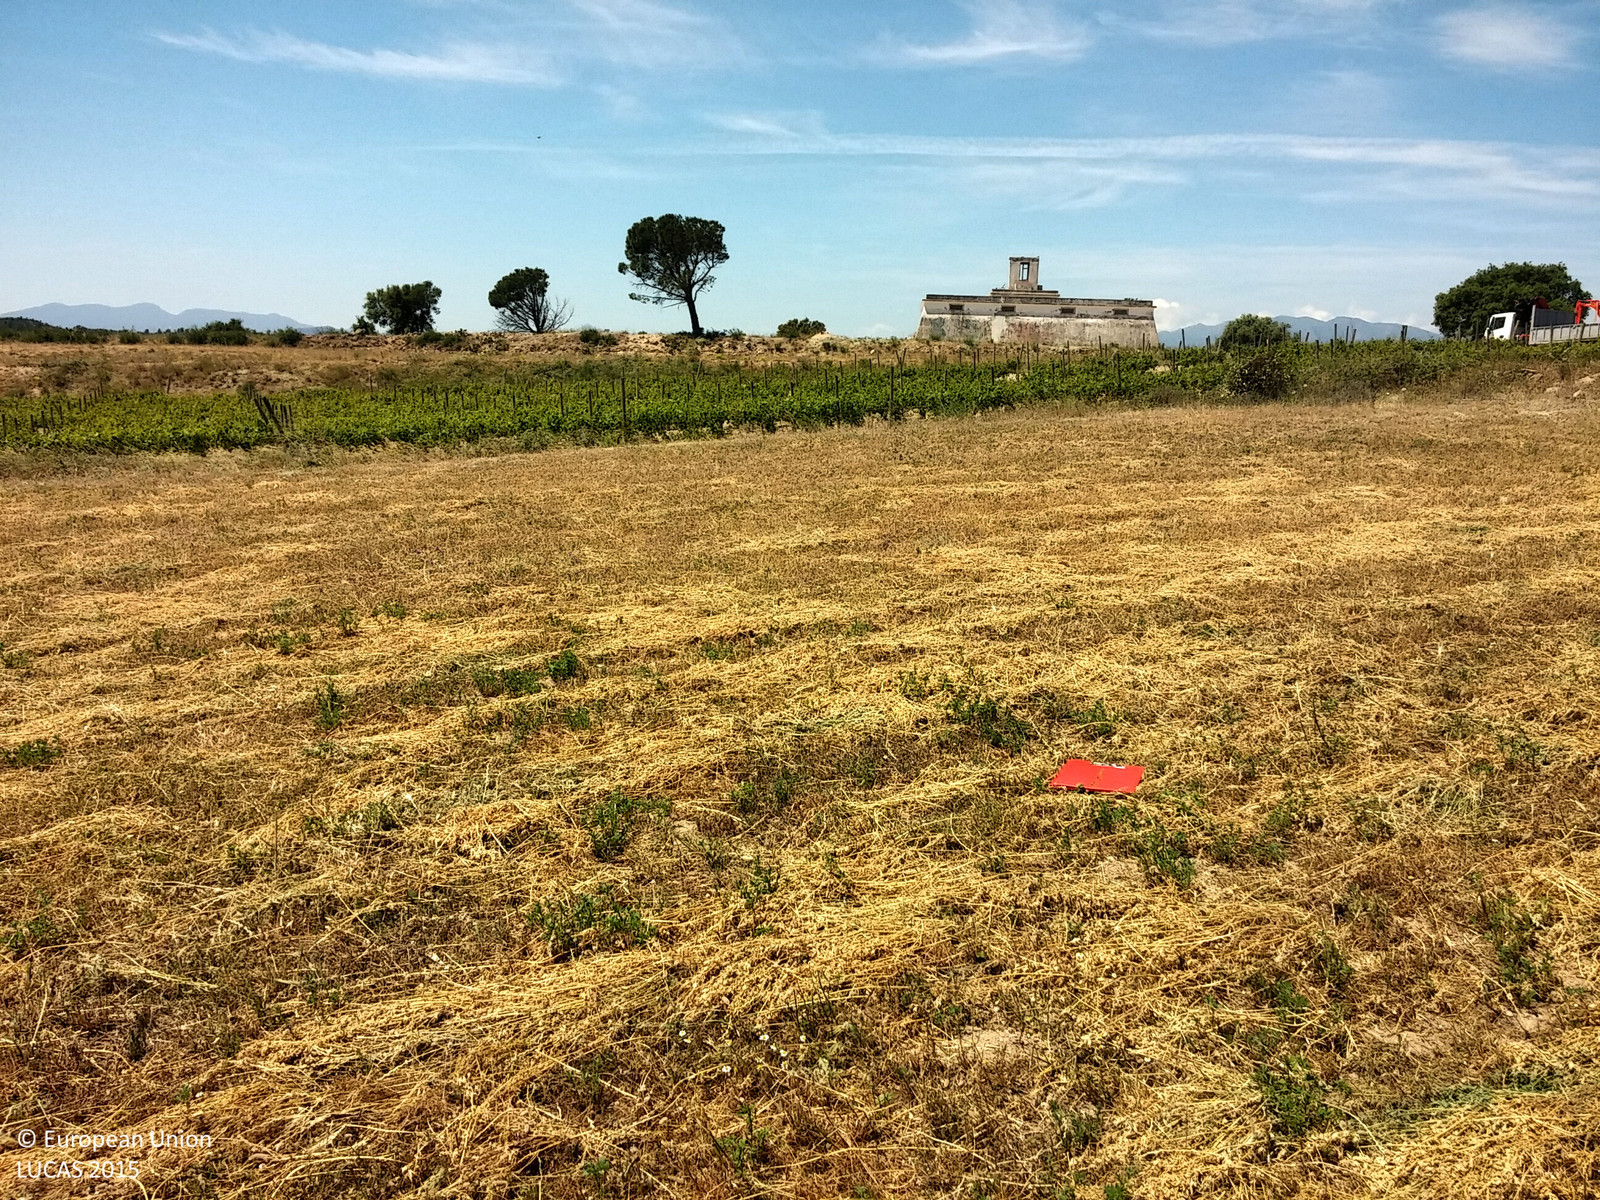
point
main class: Cropland
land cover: Lucerne
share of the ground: > 75 %
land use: Agriculture (excluding fallow land and kitchen gardens)
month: May
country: ES
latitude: 42.3742
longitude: 2.9822
